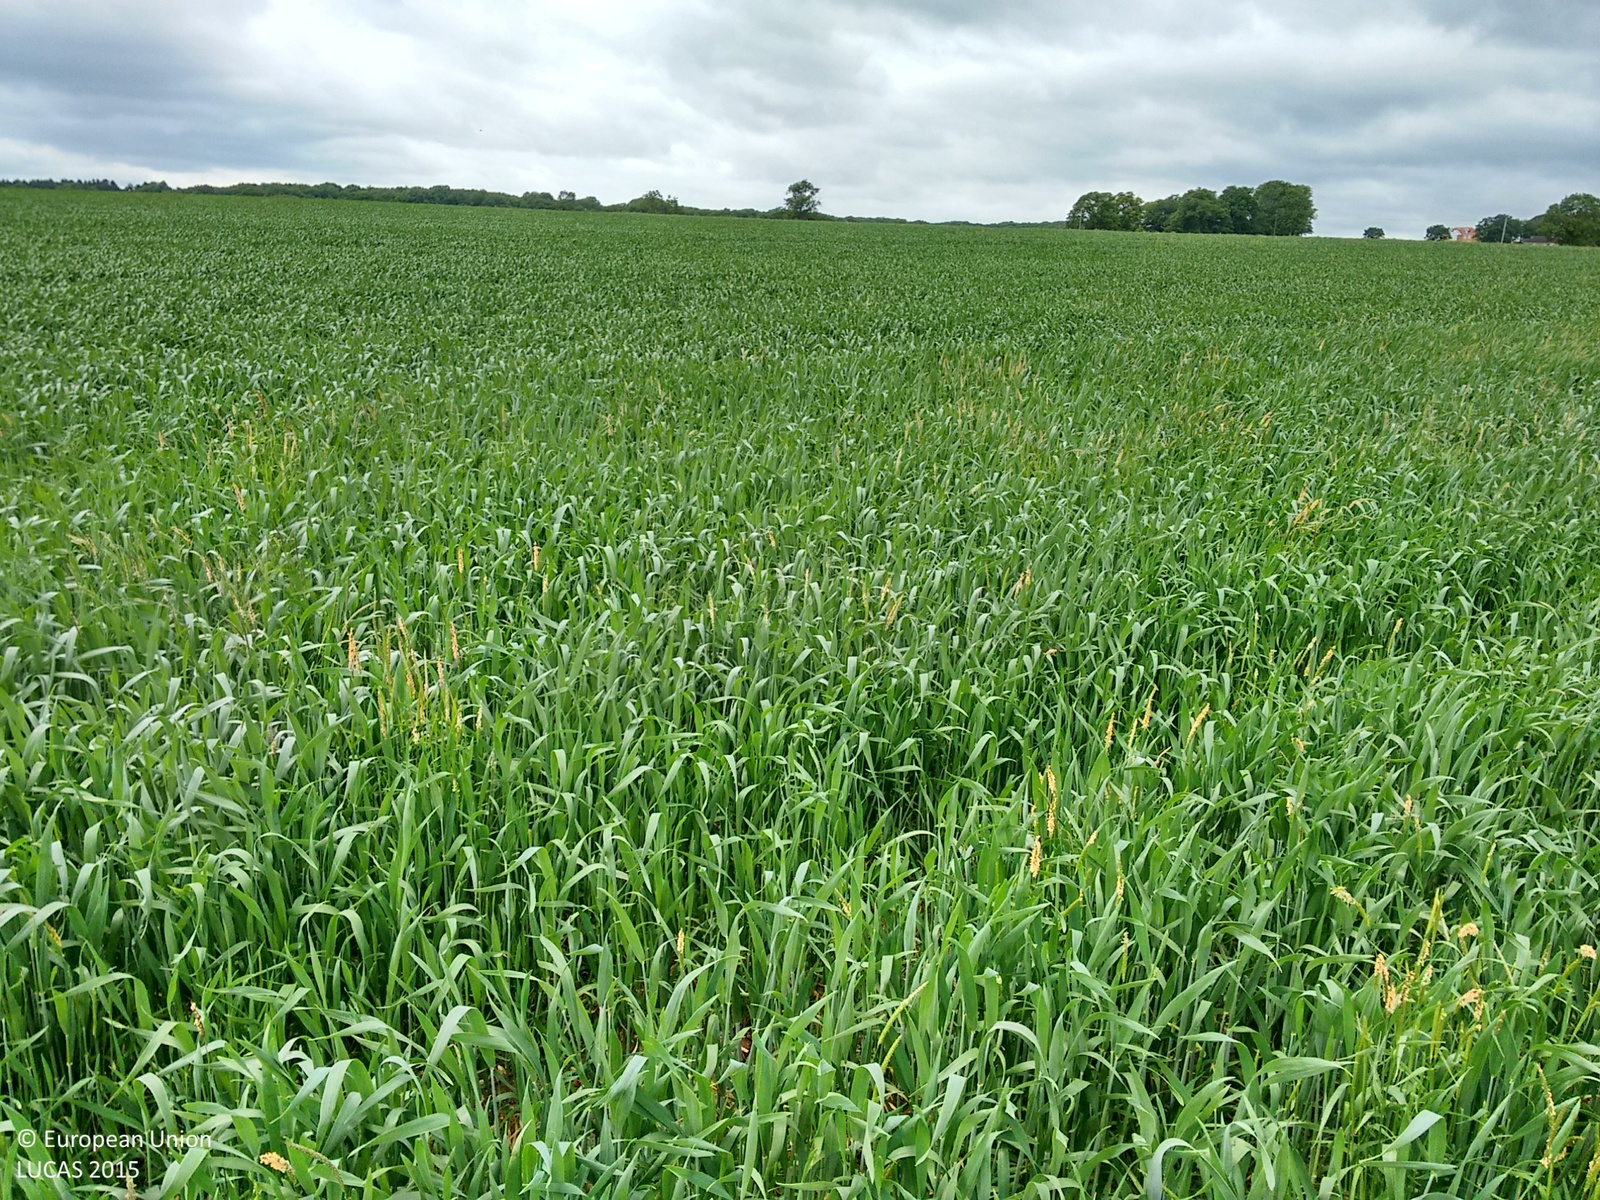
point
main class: Cropland
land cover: Common wheat
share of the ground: > 75 %
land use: Agriculture (excluding fallow land and kitchen gardens)
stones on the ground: < 10 %
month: June
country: GB
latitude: 52.1390
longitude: -0.7808
